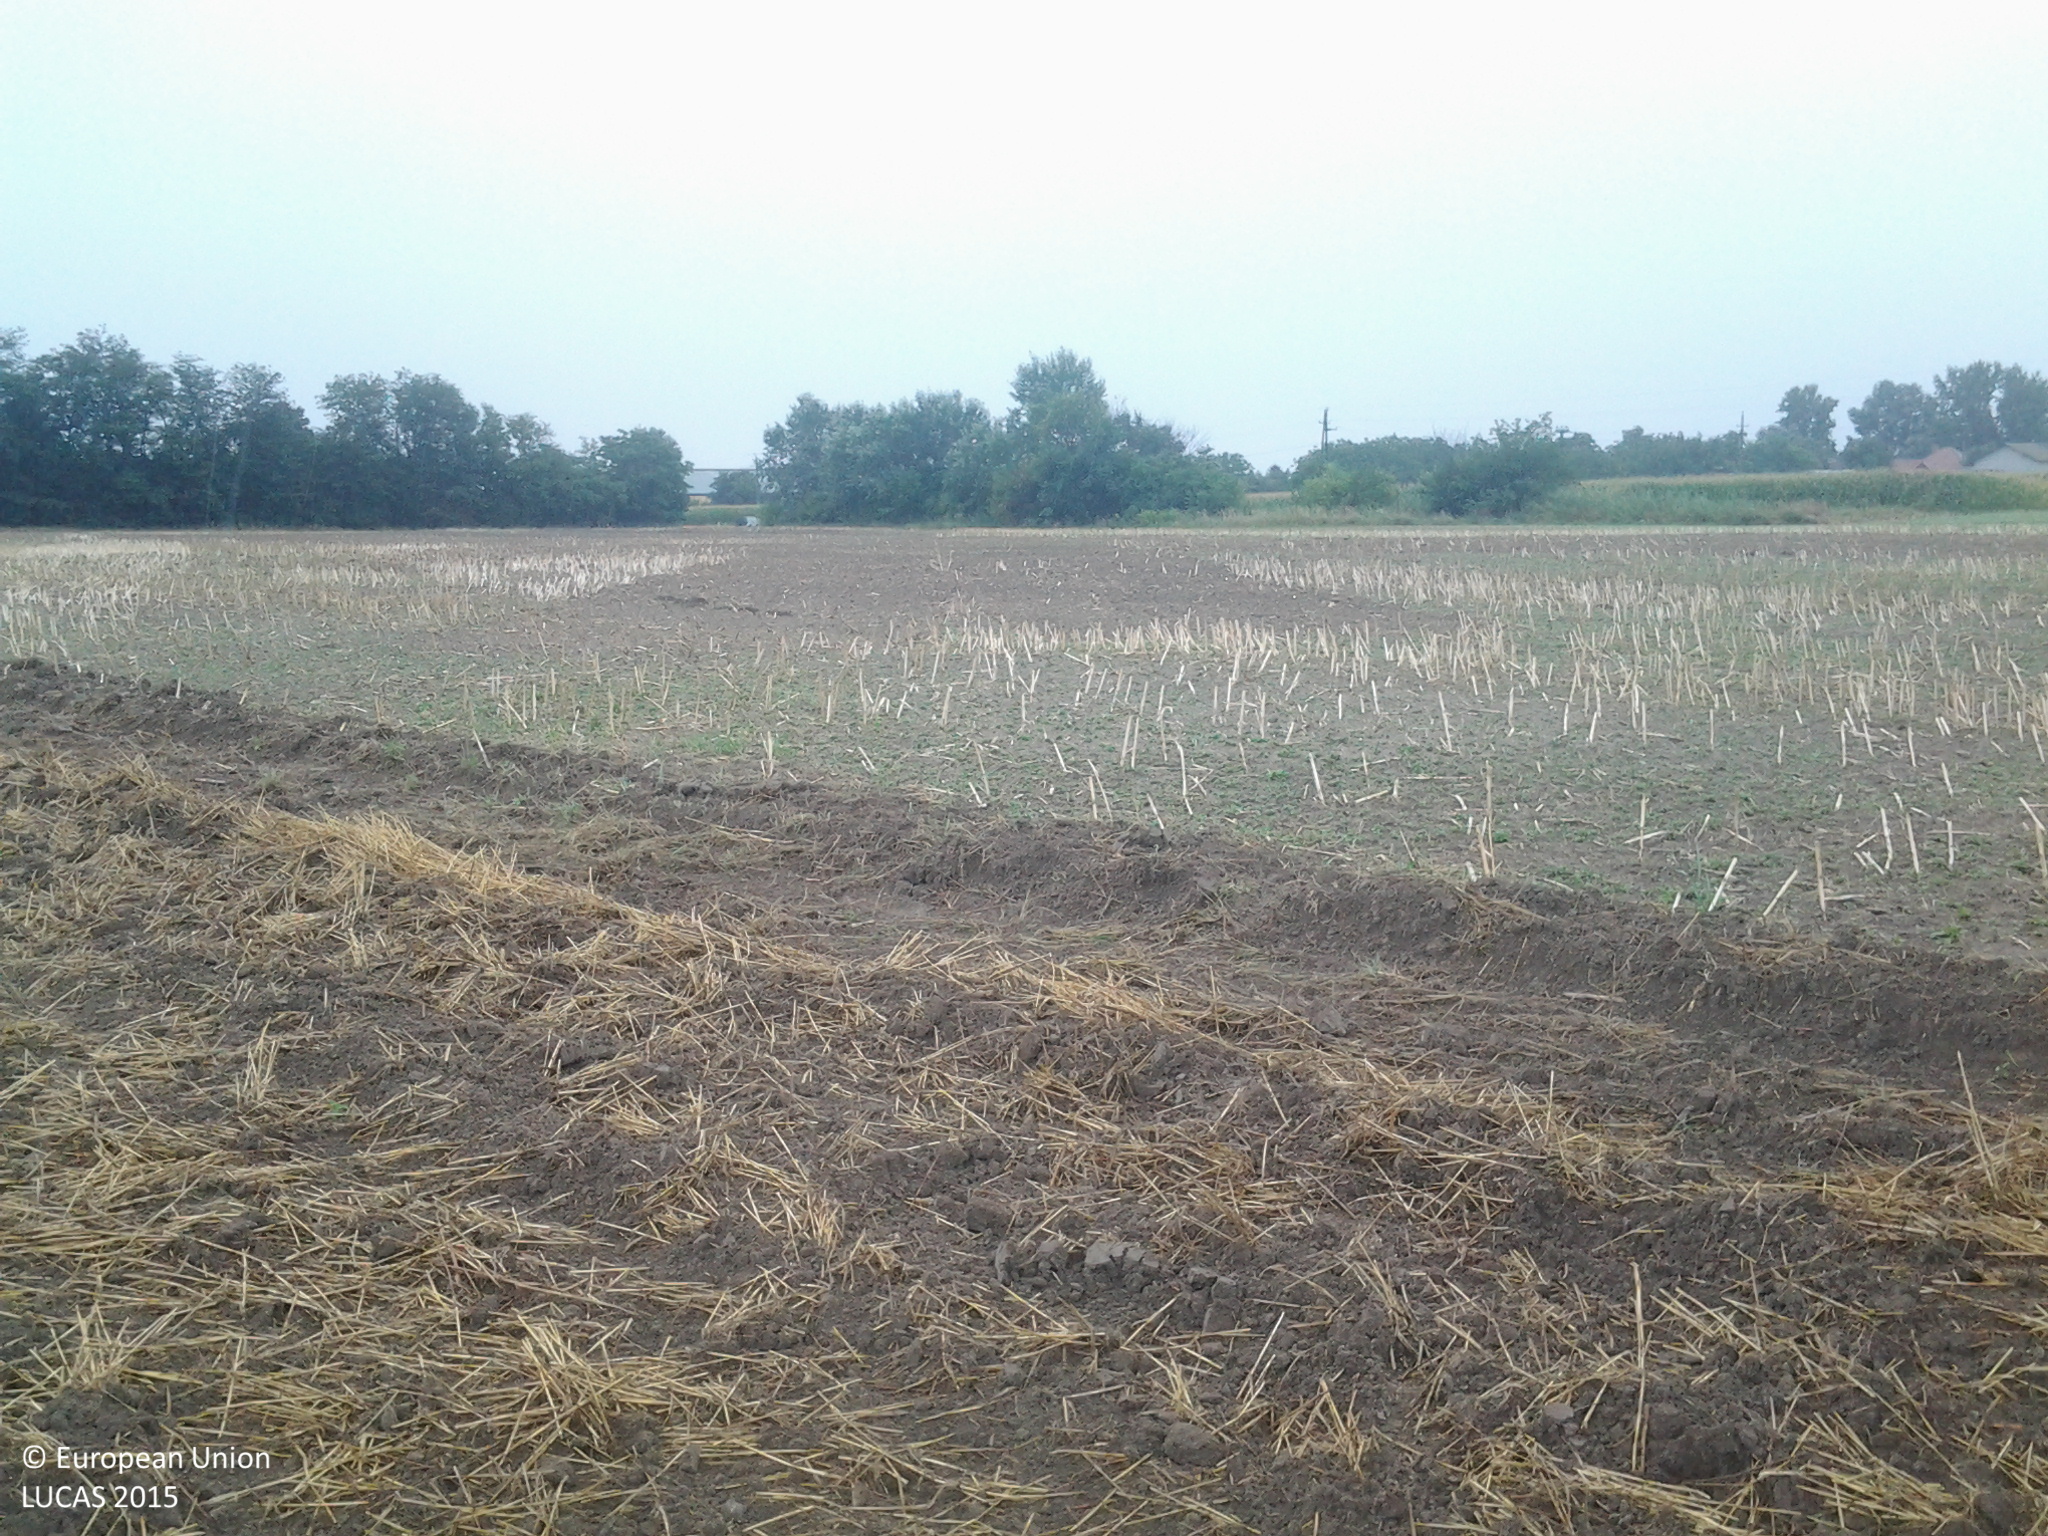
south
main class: Cropland
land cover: Common wheat
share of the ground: < 10 %
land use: Agriculture (excluding fallow land and kitchen gardens)
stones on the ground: < 10 %
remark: Harvested field
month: July
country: HU
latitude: 46.9838
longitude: 19.0215
